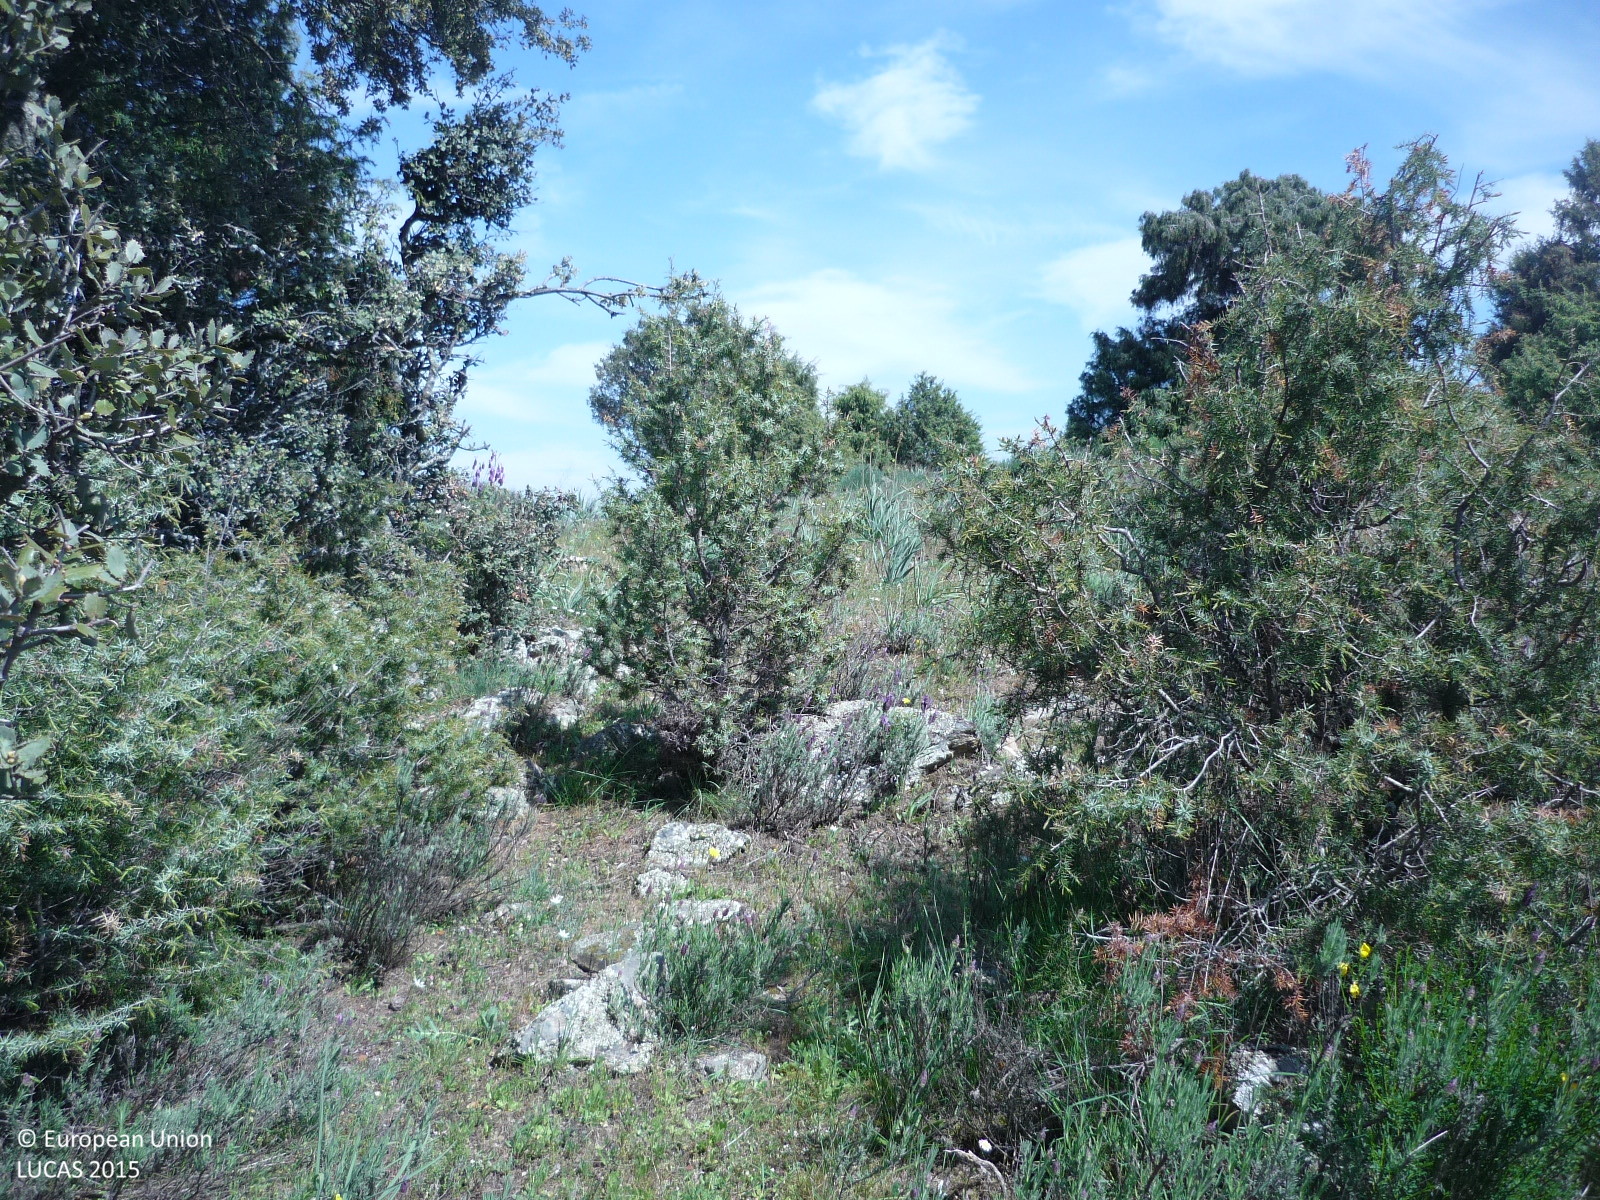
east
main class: Woodland
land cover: Spruce dominated coniferous woodland
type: coniferous forest of the mediterranean region
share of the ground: > 75 %
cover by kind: coniferous forest trees 75 %, shrubs 15 %, herbaceous plants 10 %
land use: Semi-natural and natural areas not in use
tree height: < 5 m
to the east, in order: Spruce dominated coniferous woodland; Tracks; Grassland with sparse tree/shrub cover; Shrubland with sparse tree cover; Grassland with sparse tree/shrub cover; Rocks and stones; Inland fresh water bodies
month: April
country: ES
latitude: 40.7584
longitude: -3.6275
